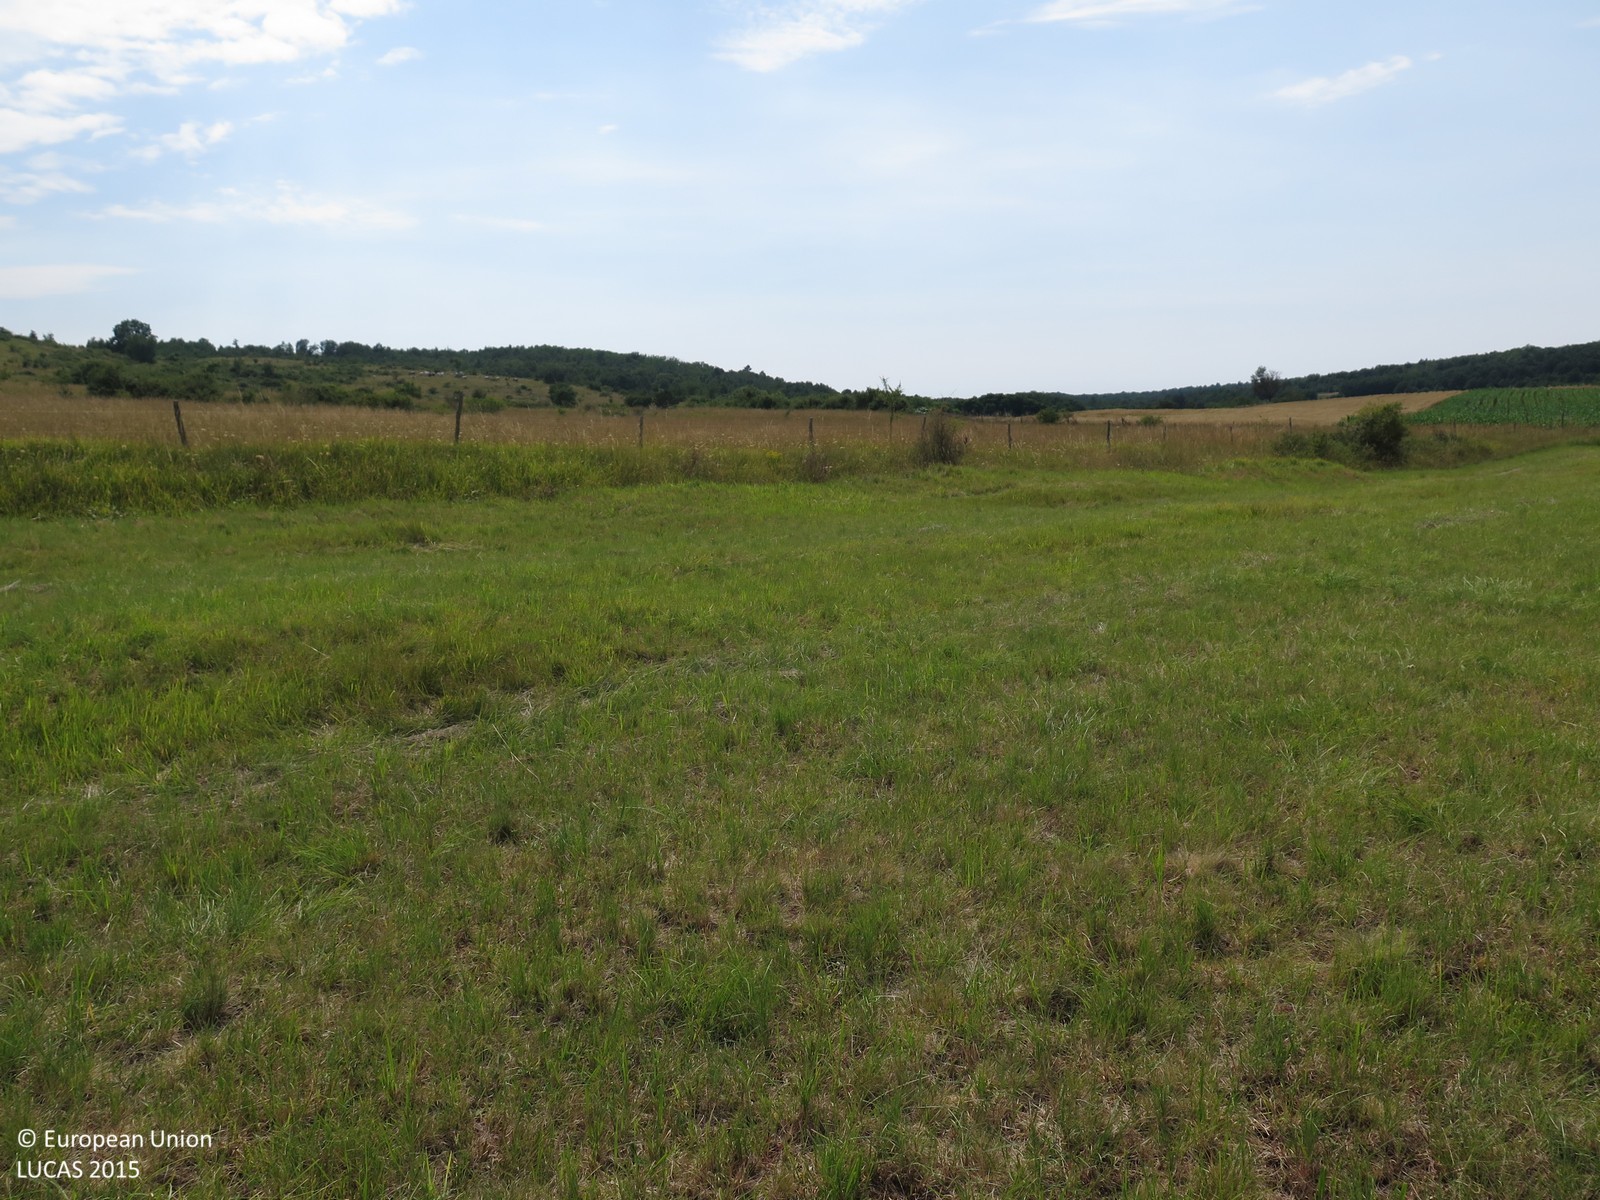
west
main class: Grassland
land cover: Grassland without tree/shrub cover
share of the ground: > 75 %
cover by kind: herbaceous plants 100 %
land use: Agriculture (excluding fallow land and kitchen gardens)
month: June
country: HR
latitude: 45.2734
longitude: 13.8061
